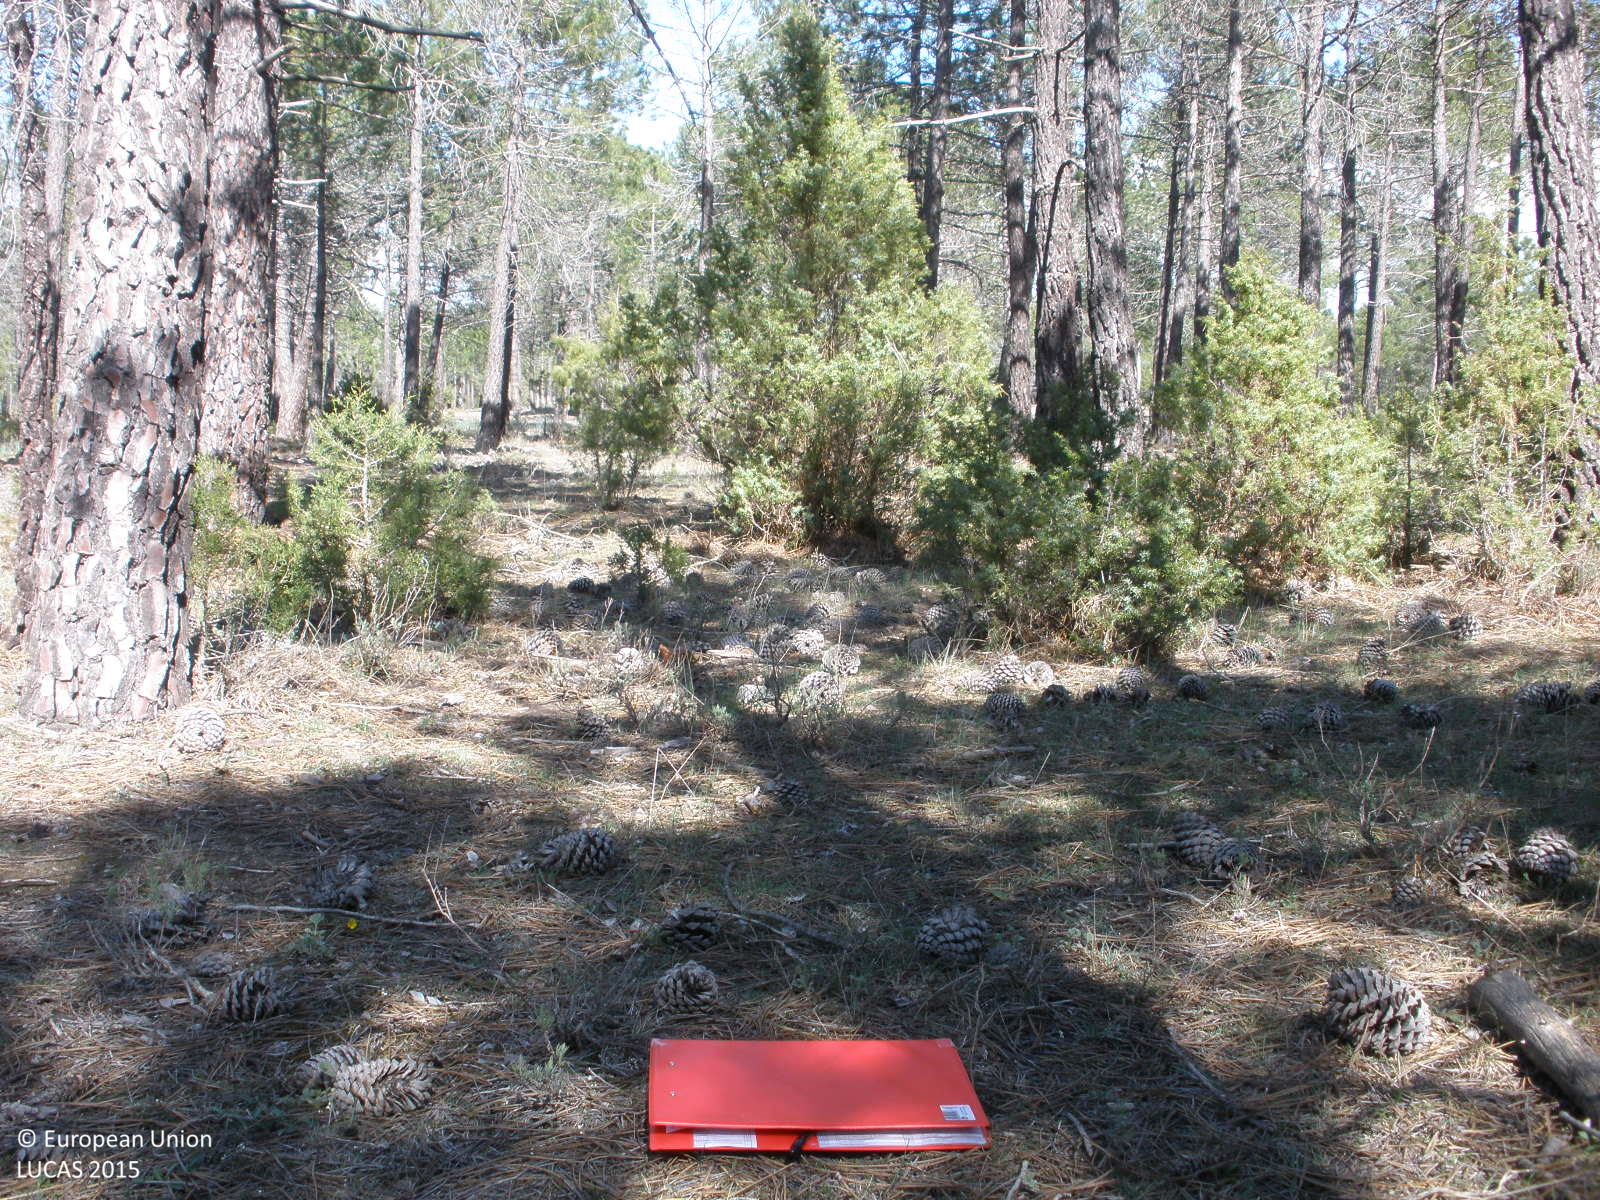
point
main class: Woodland
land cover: Pine dominated coniferous woodland
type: coniferous forest of the mediterranean region
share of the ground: 50 - 75 %
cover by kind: coniferous forest trees 60 %, shrubs 20 %, consolidated bare surface 20 %
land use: Semi-natural and natural areas not in use
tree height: > 5 m
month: April
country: ES
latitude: 40.2912
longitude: -1.2688
